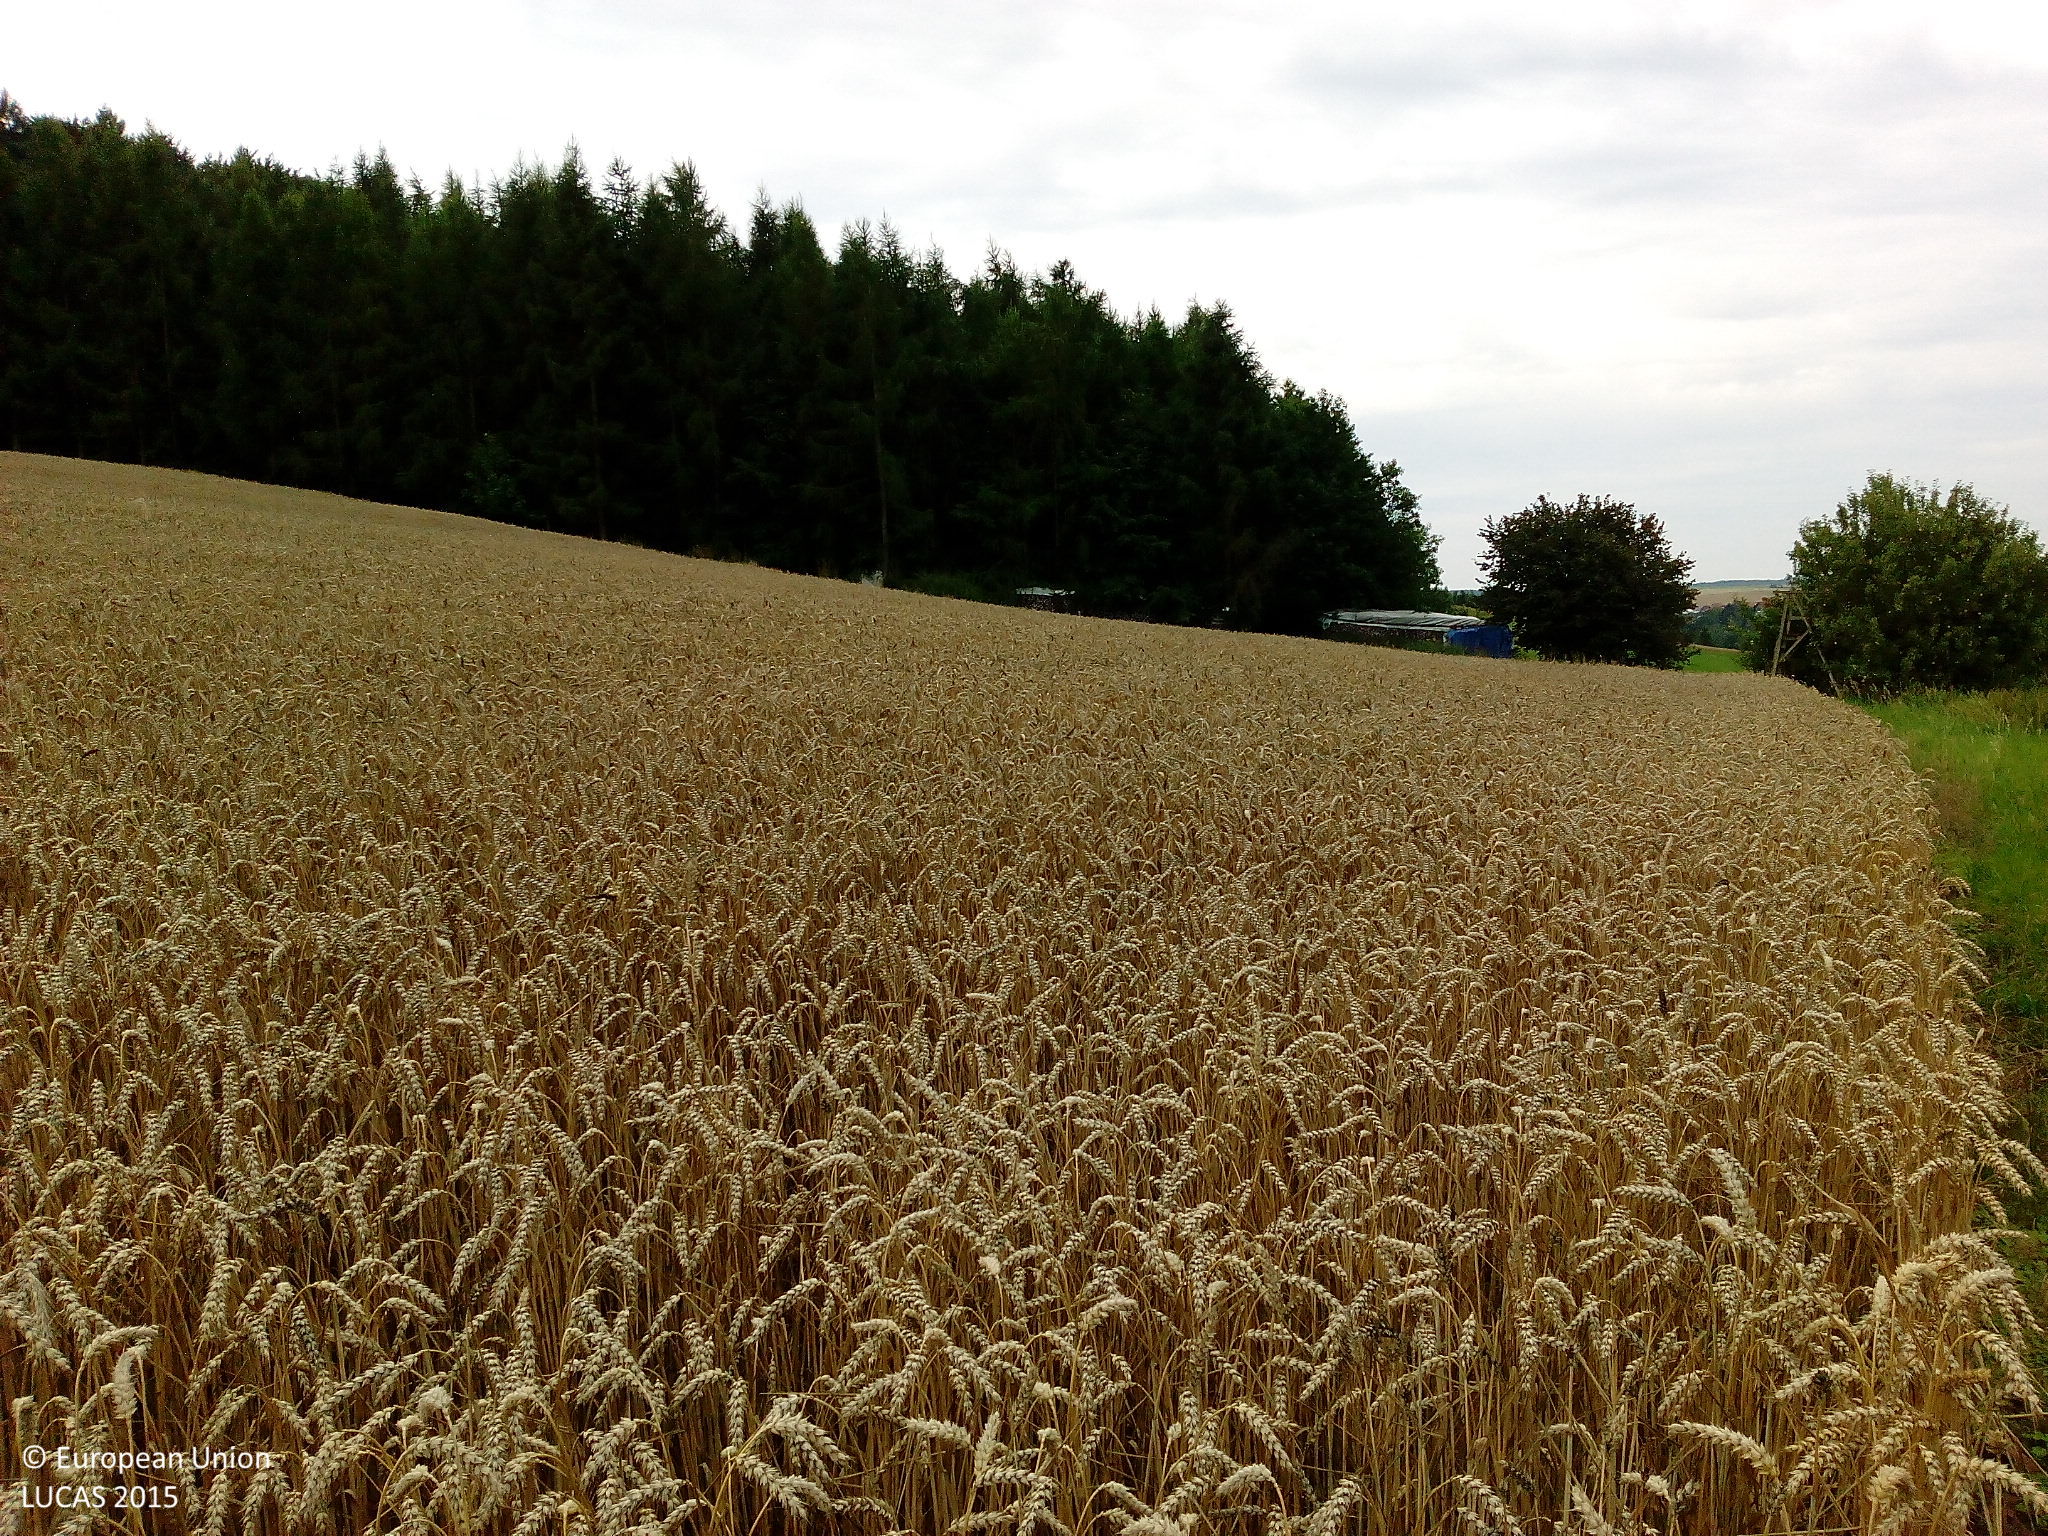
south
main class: Cropland
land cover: Common wheat
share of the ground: > 75 %
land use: Agriculture (excluding fallow land and kitchen gardens)
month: August
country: DE
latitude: 50.7409
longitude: 9.5892
